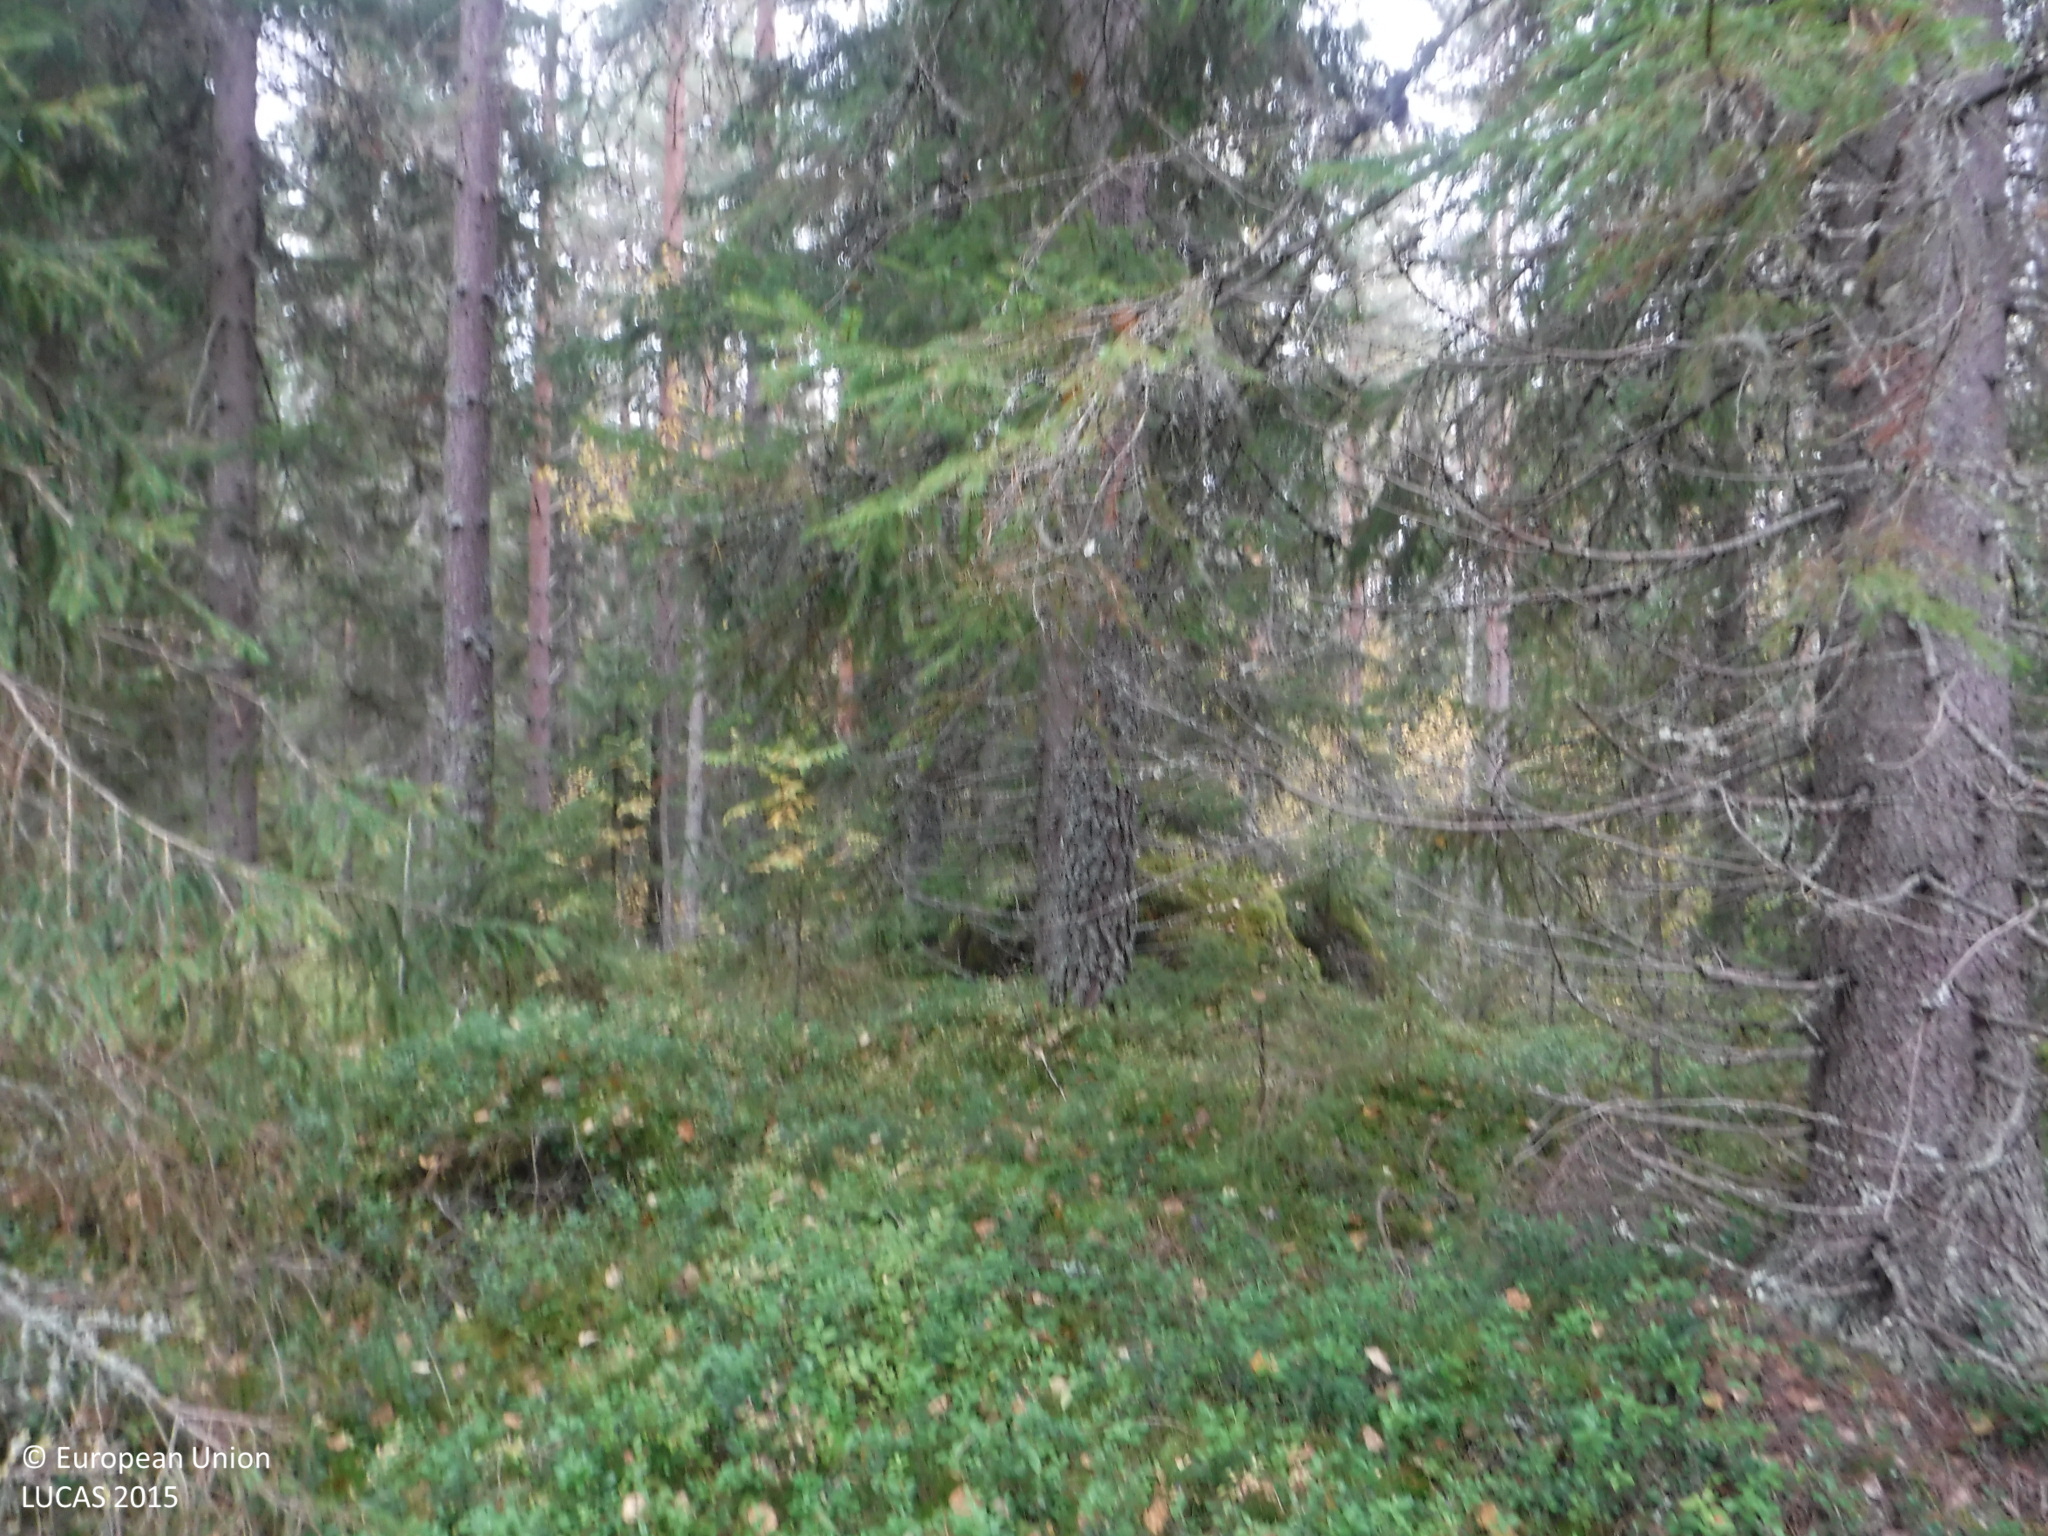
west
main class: Woodland
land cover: Other coniferous woodland
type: boreal forest
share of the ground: 50 - 75 %
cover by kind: coniferous forest trees 55 %, lichens and mosses 20 %, shrubs 15 %, broadleaved forest trees 10 %
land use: Forestry
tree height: > 5 m
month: September
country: FI
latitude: 61.7756
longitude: 24.1342
